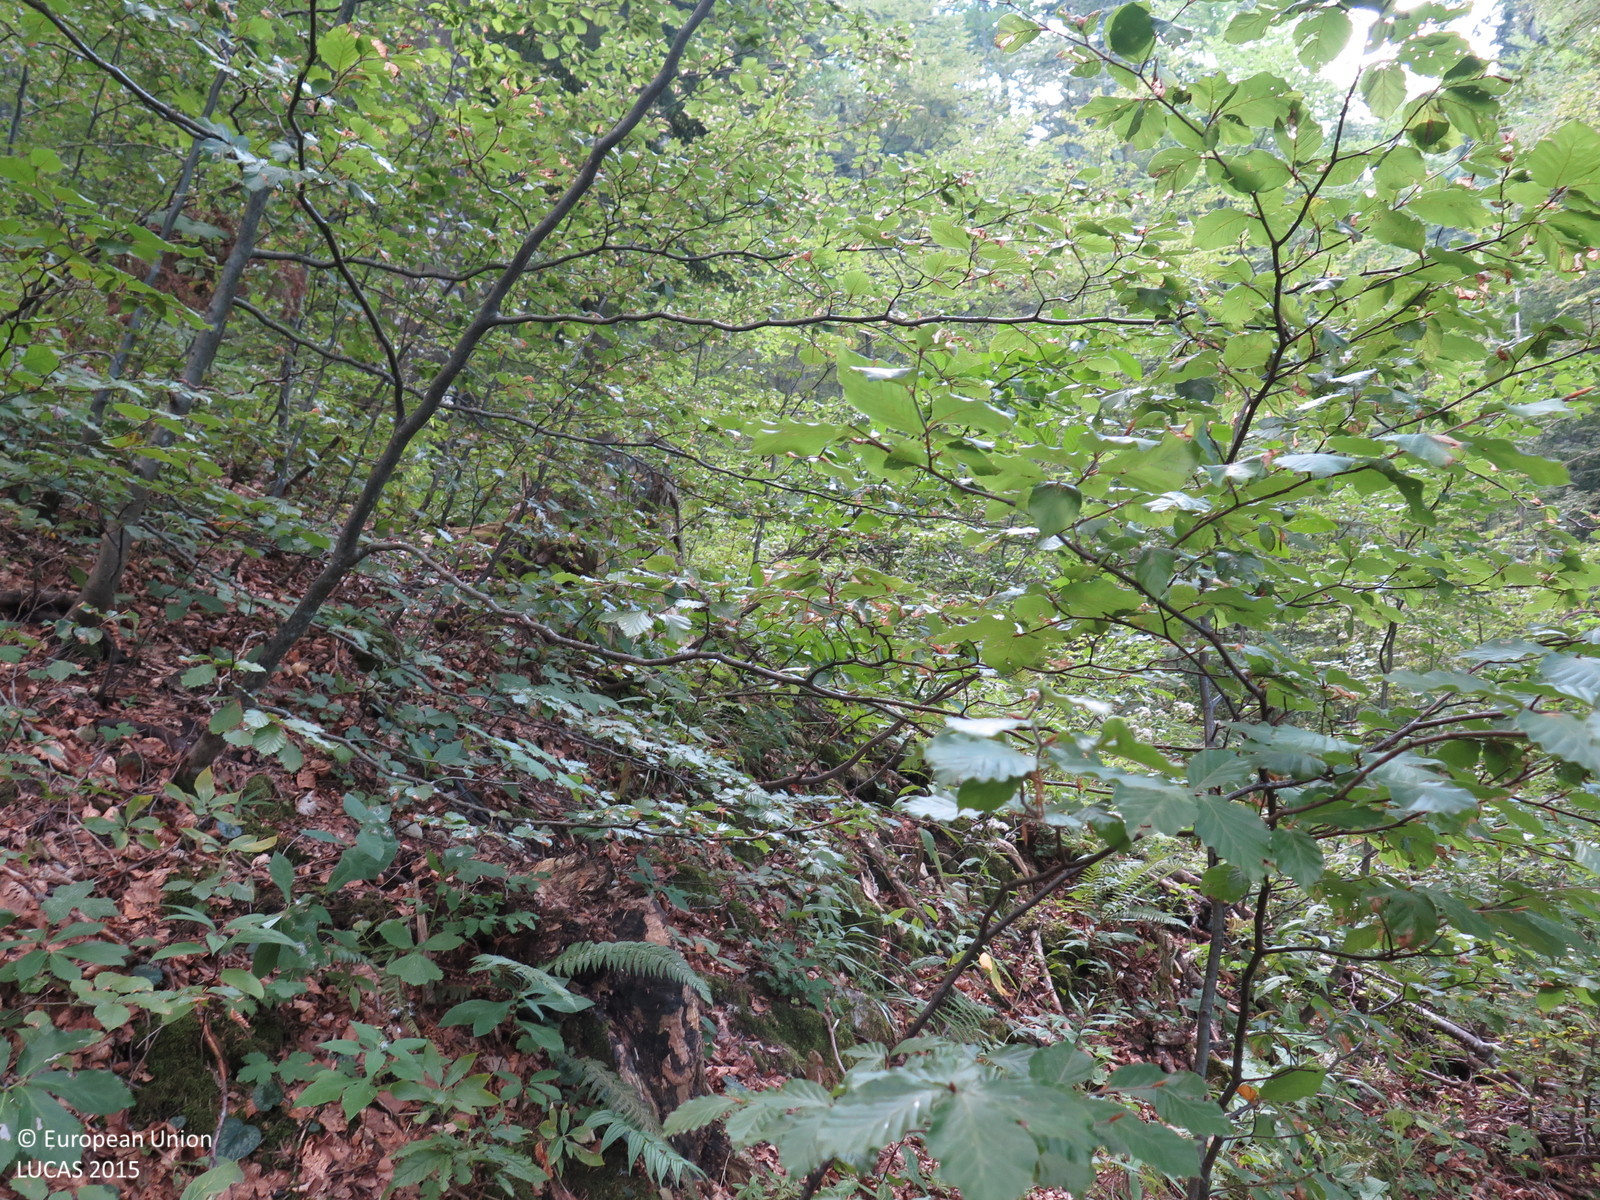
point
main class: Woodland
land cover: Other mixed woodland
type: mountainous beech forest
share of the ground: > 75 %
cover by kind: coniferous forest trees 75 %, broadleaved forest trees 25 %
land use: Forestry
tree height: > 5 m
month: August
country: HR
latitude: 45.3685
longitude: 14.9876
